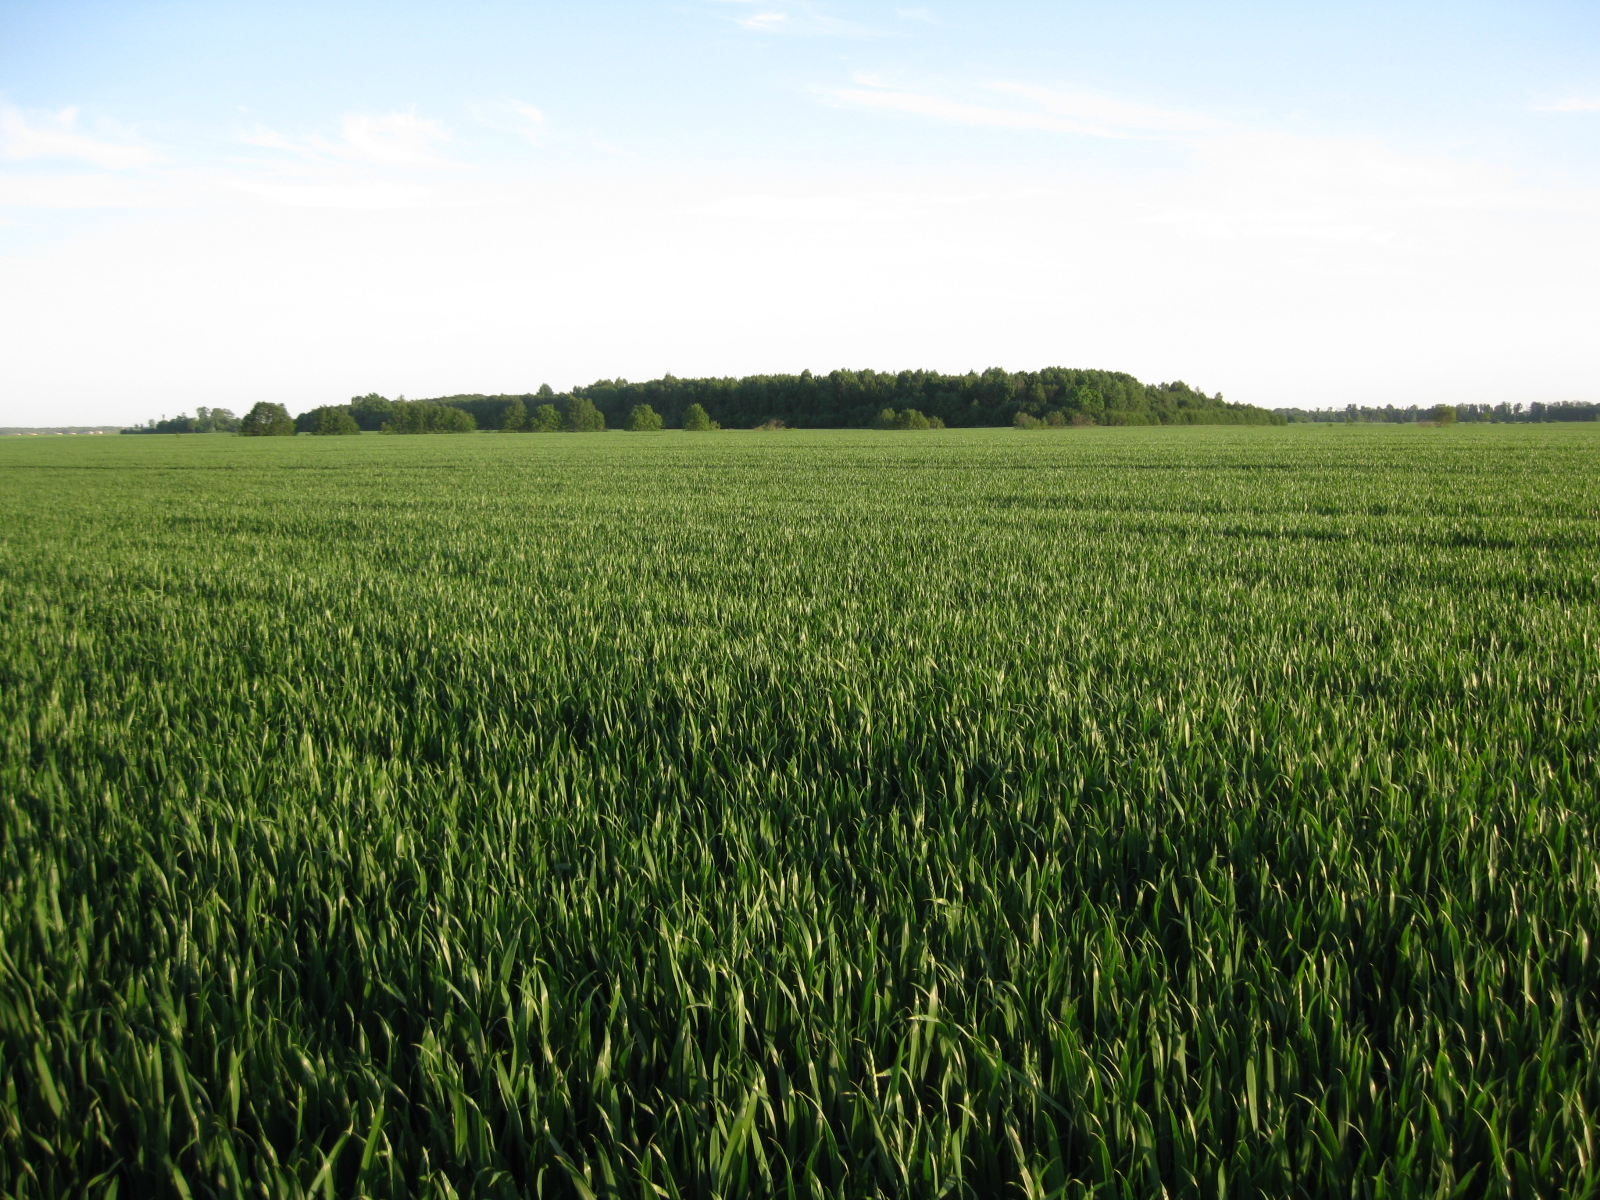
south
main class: Cropland
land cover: Common wheat
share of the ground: > 75 %
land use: Agriculture (excluding fallow land and kitchen gardens)
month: June
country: LT
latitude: 55.6743
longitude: 23.9696
